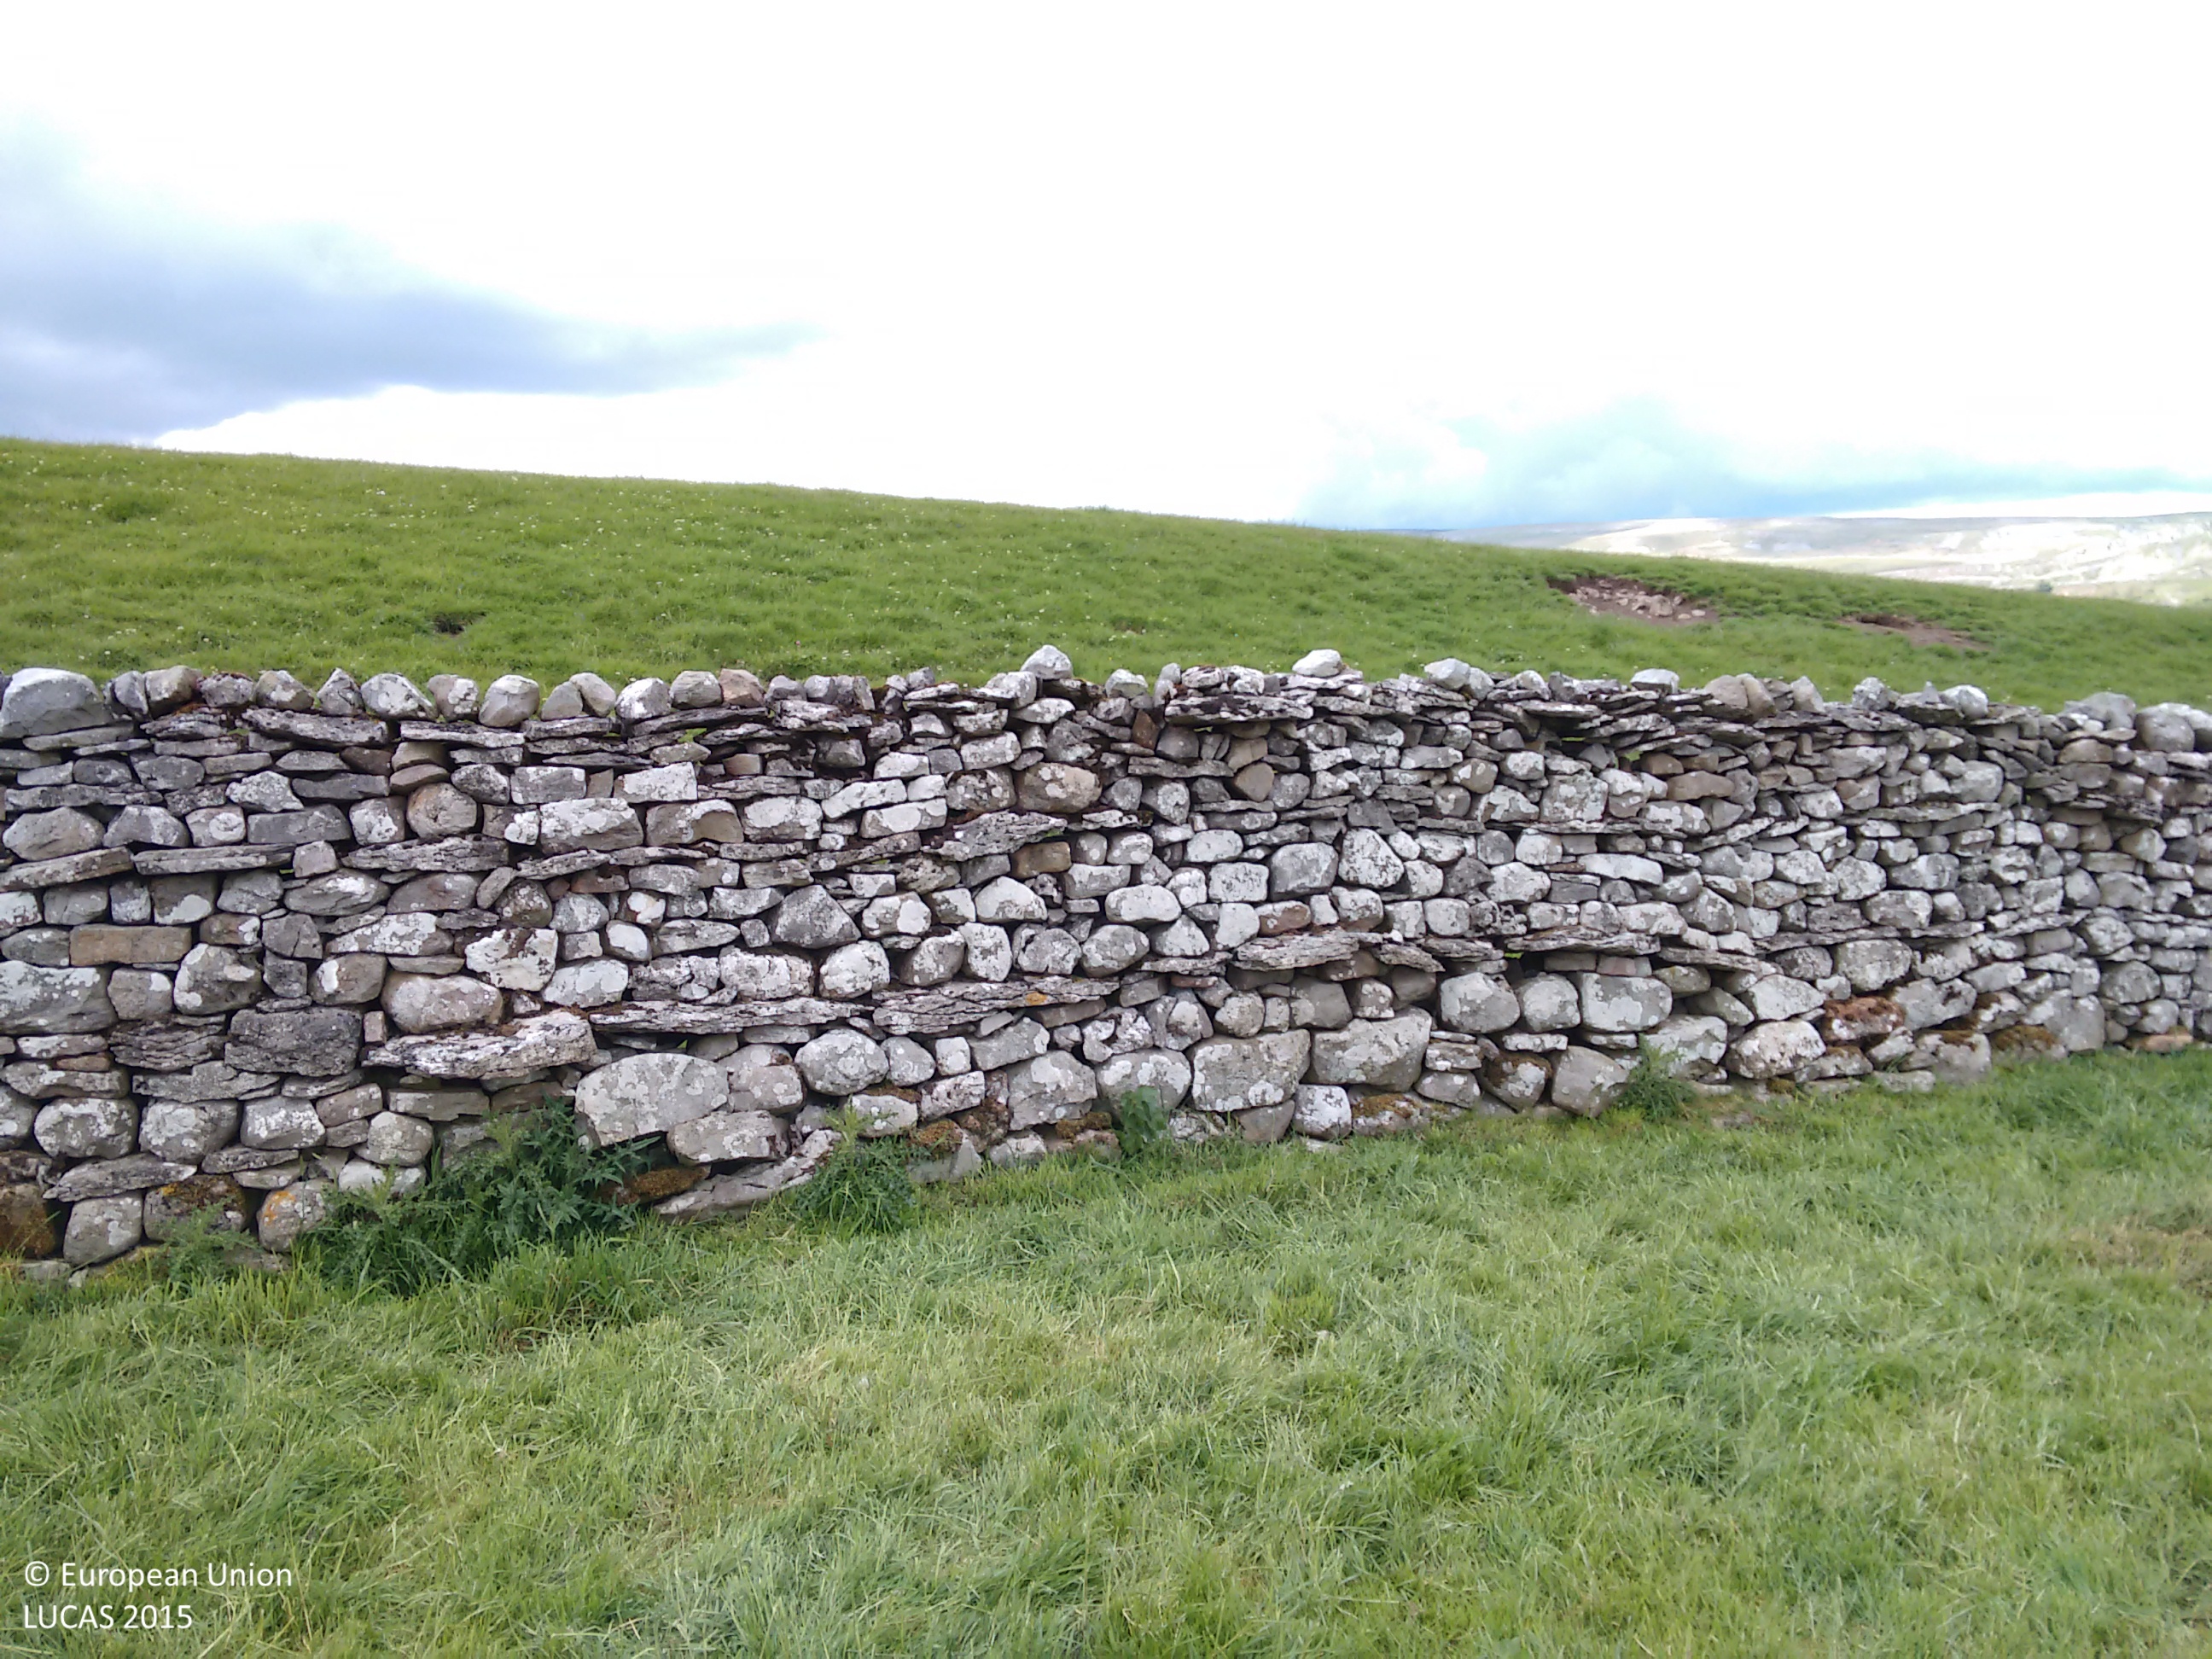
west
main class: Grassland
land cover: Grassland without tree/shrub cover
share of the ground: > 75 %
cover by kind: herbaceous plants 100 %
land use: Agriculture (excluding fallow land and kitchen gardens)
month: June
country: GB
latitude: 54.2916
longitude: -2.0246
